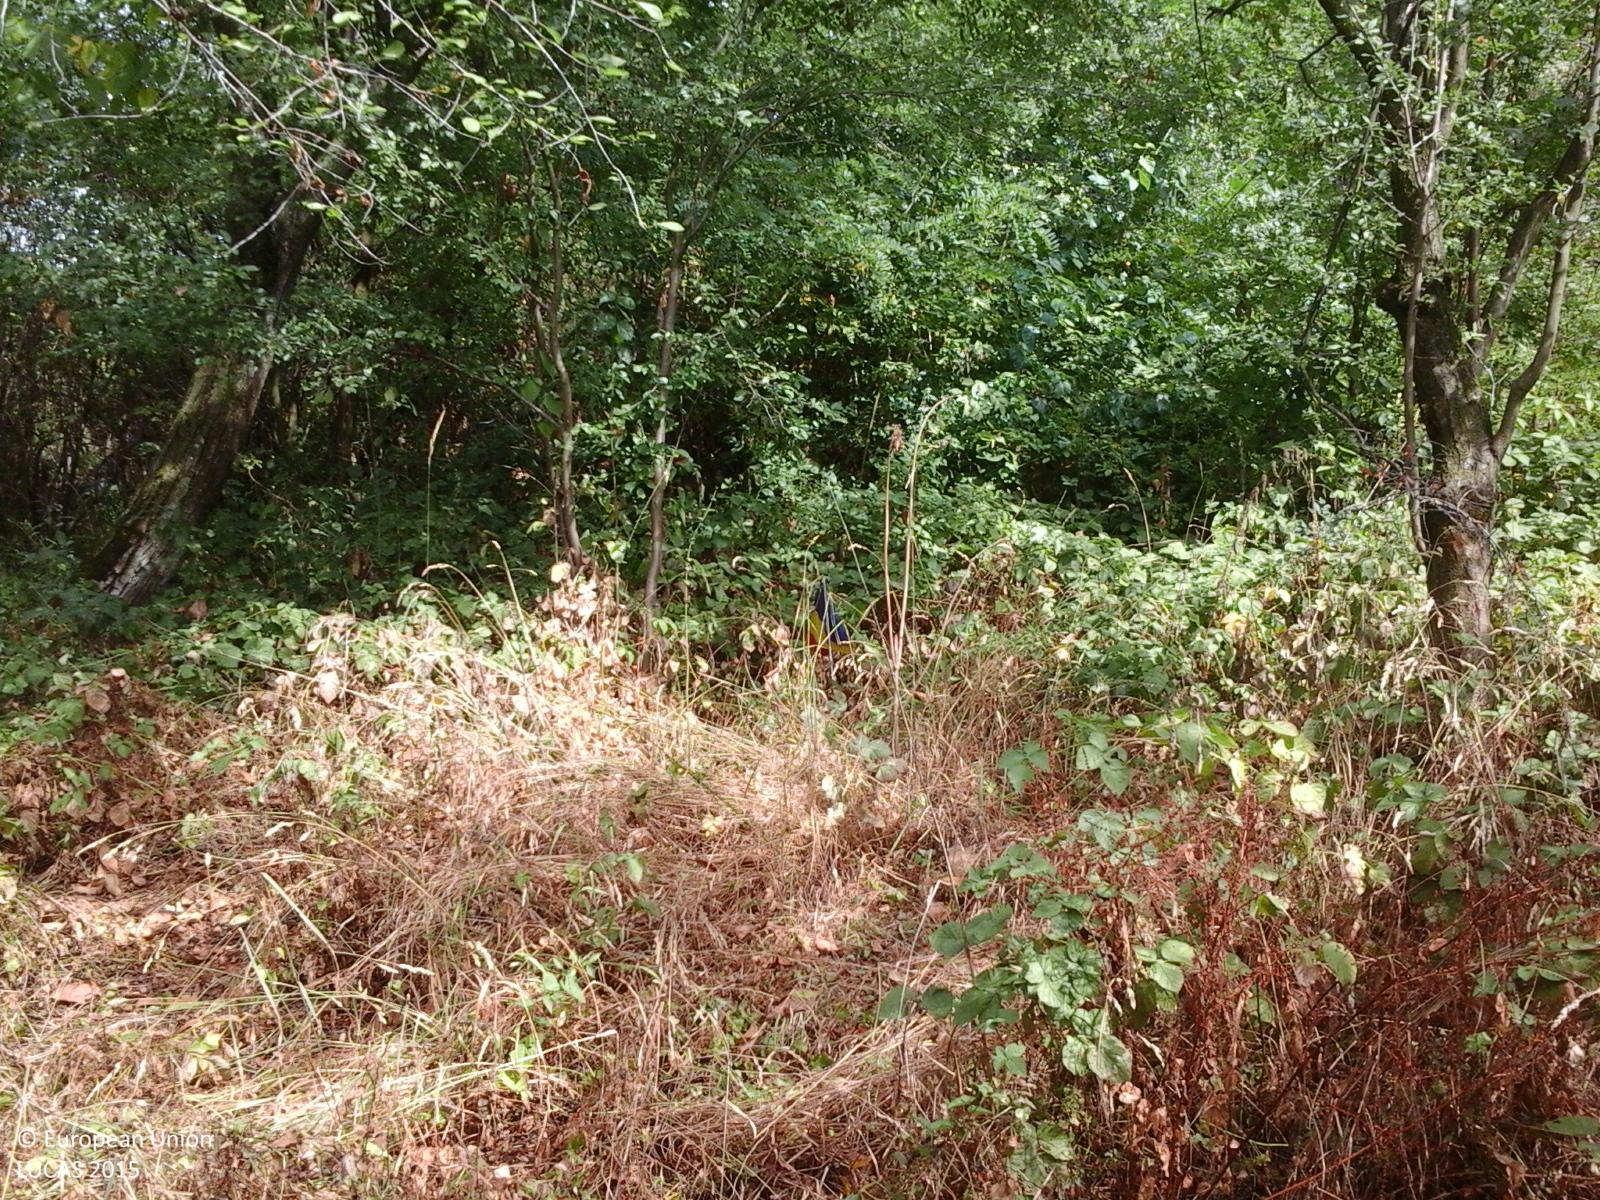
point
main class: Woodland
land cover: Broadleaved woodland
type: exotic forest
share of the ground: > 75 %
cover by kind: broadleaved forest trees 100 %
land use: Forestry
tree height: > 5 m
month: August
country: RO
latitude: 44.6350
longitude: 22.7626
